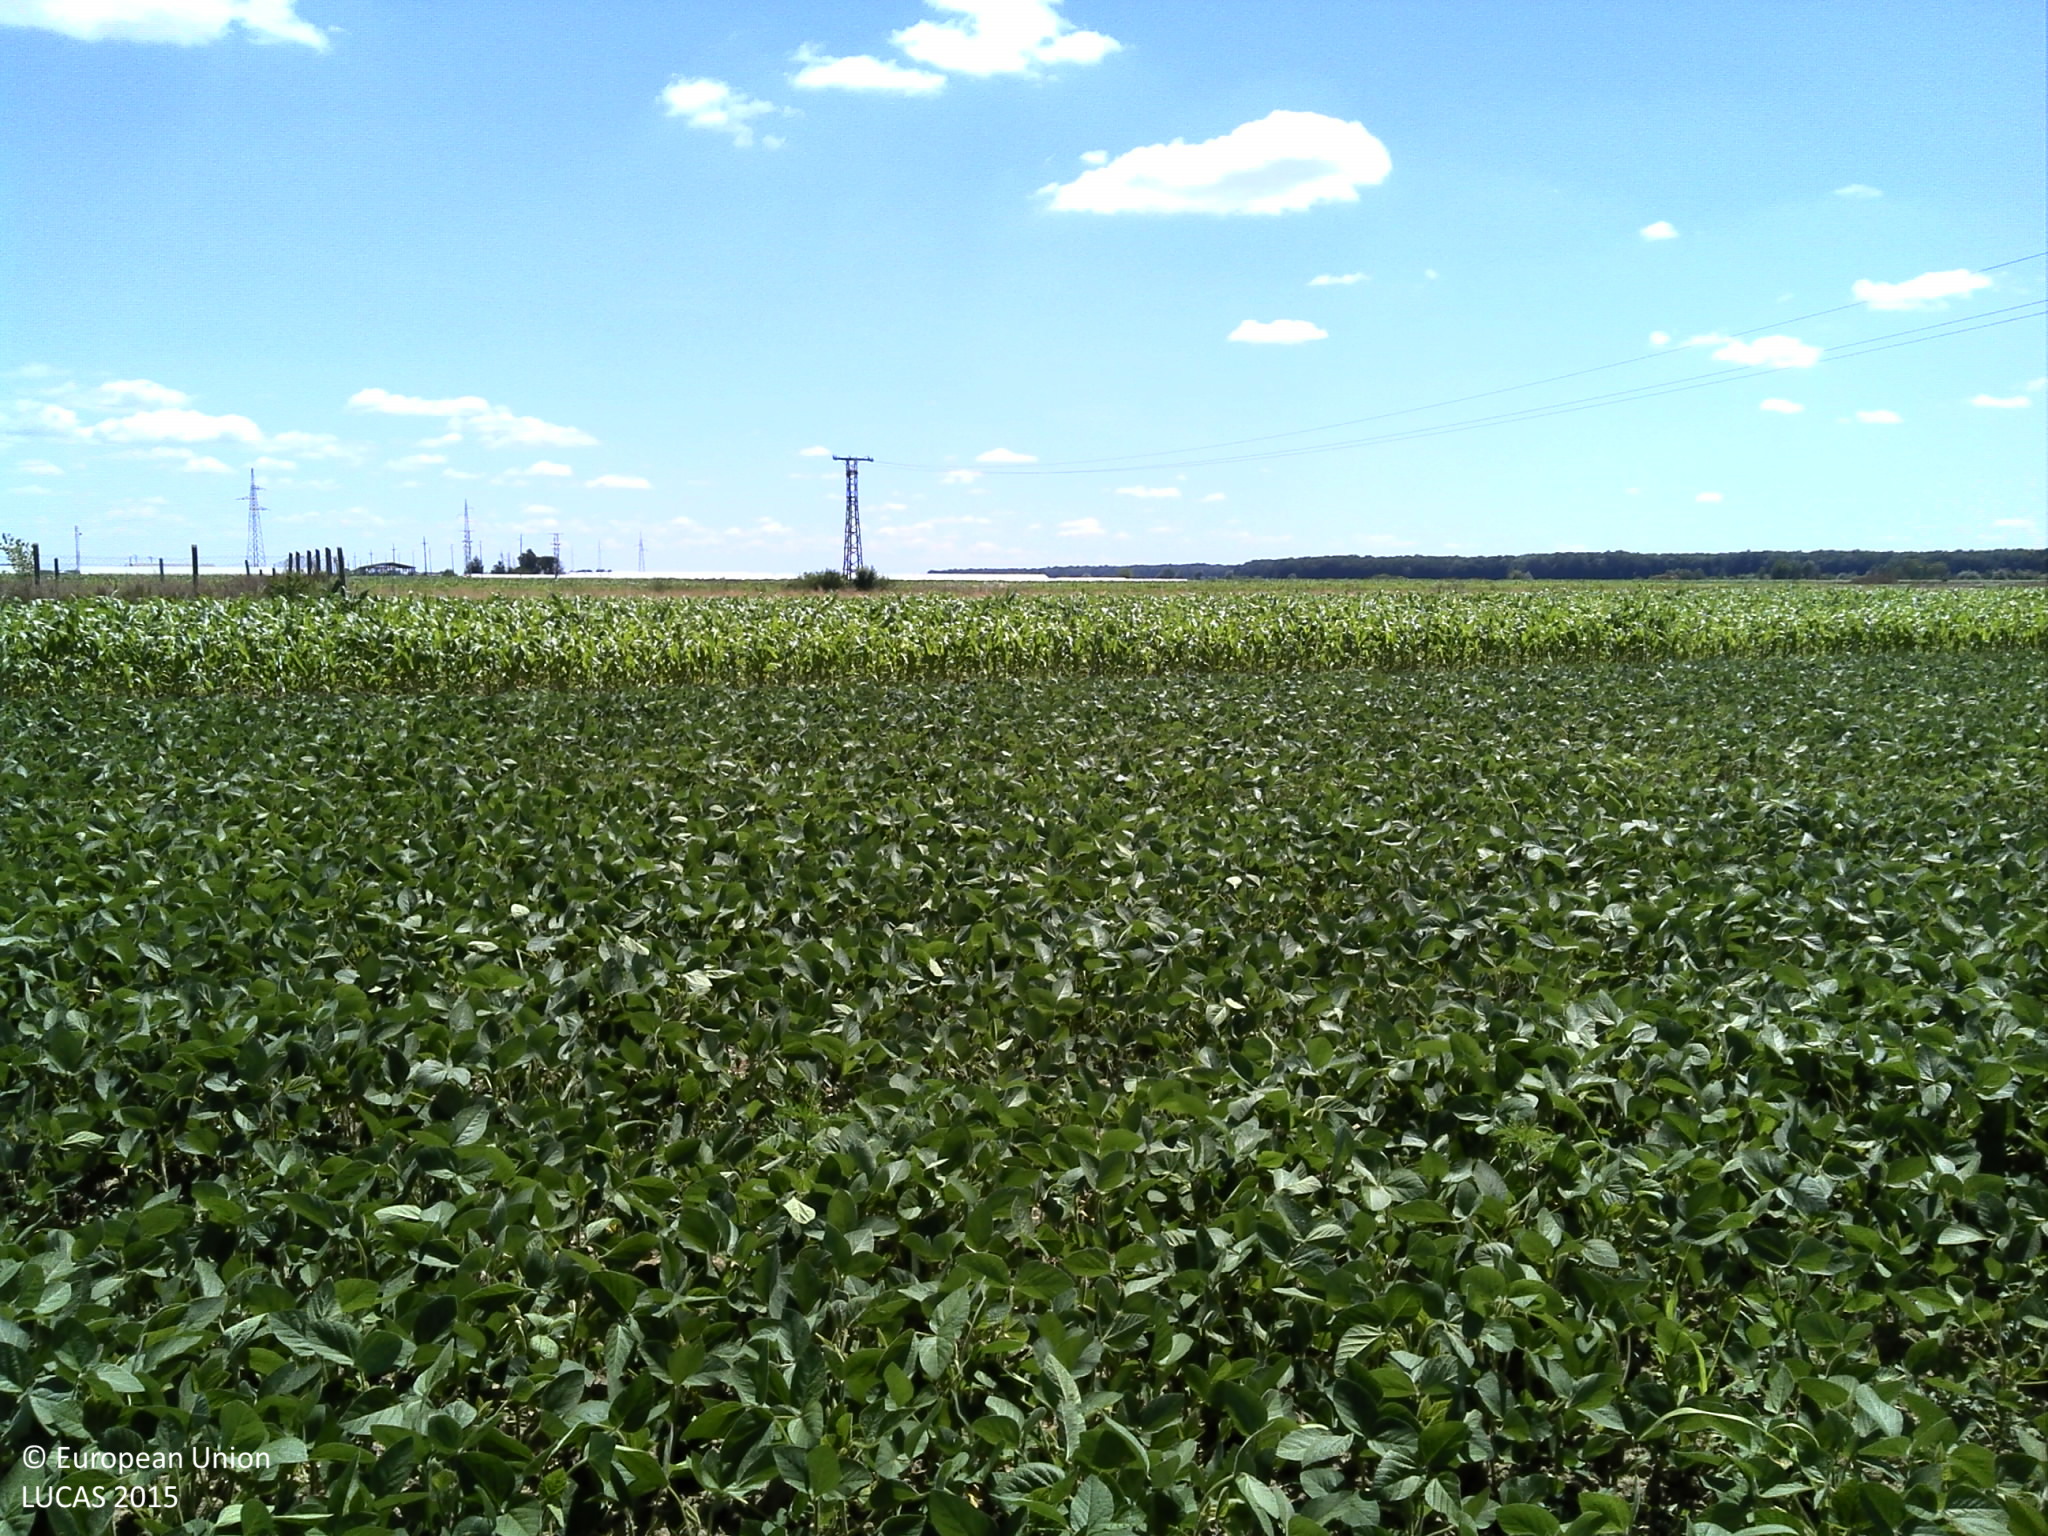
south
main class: Cropland
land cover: Barley
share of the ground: < 10 %
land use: Agriculture (excluding fallow land and kitchen gardens)
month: June
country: HR
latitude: 45.7488
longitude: 18.1681
